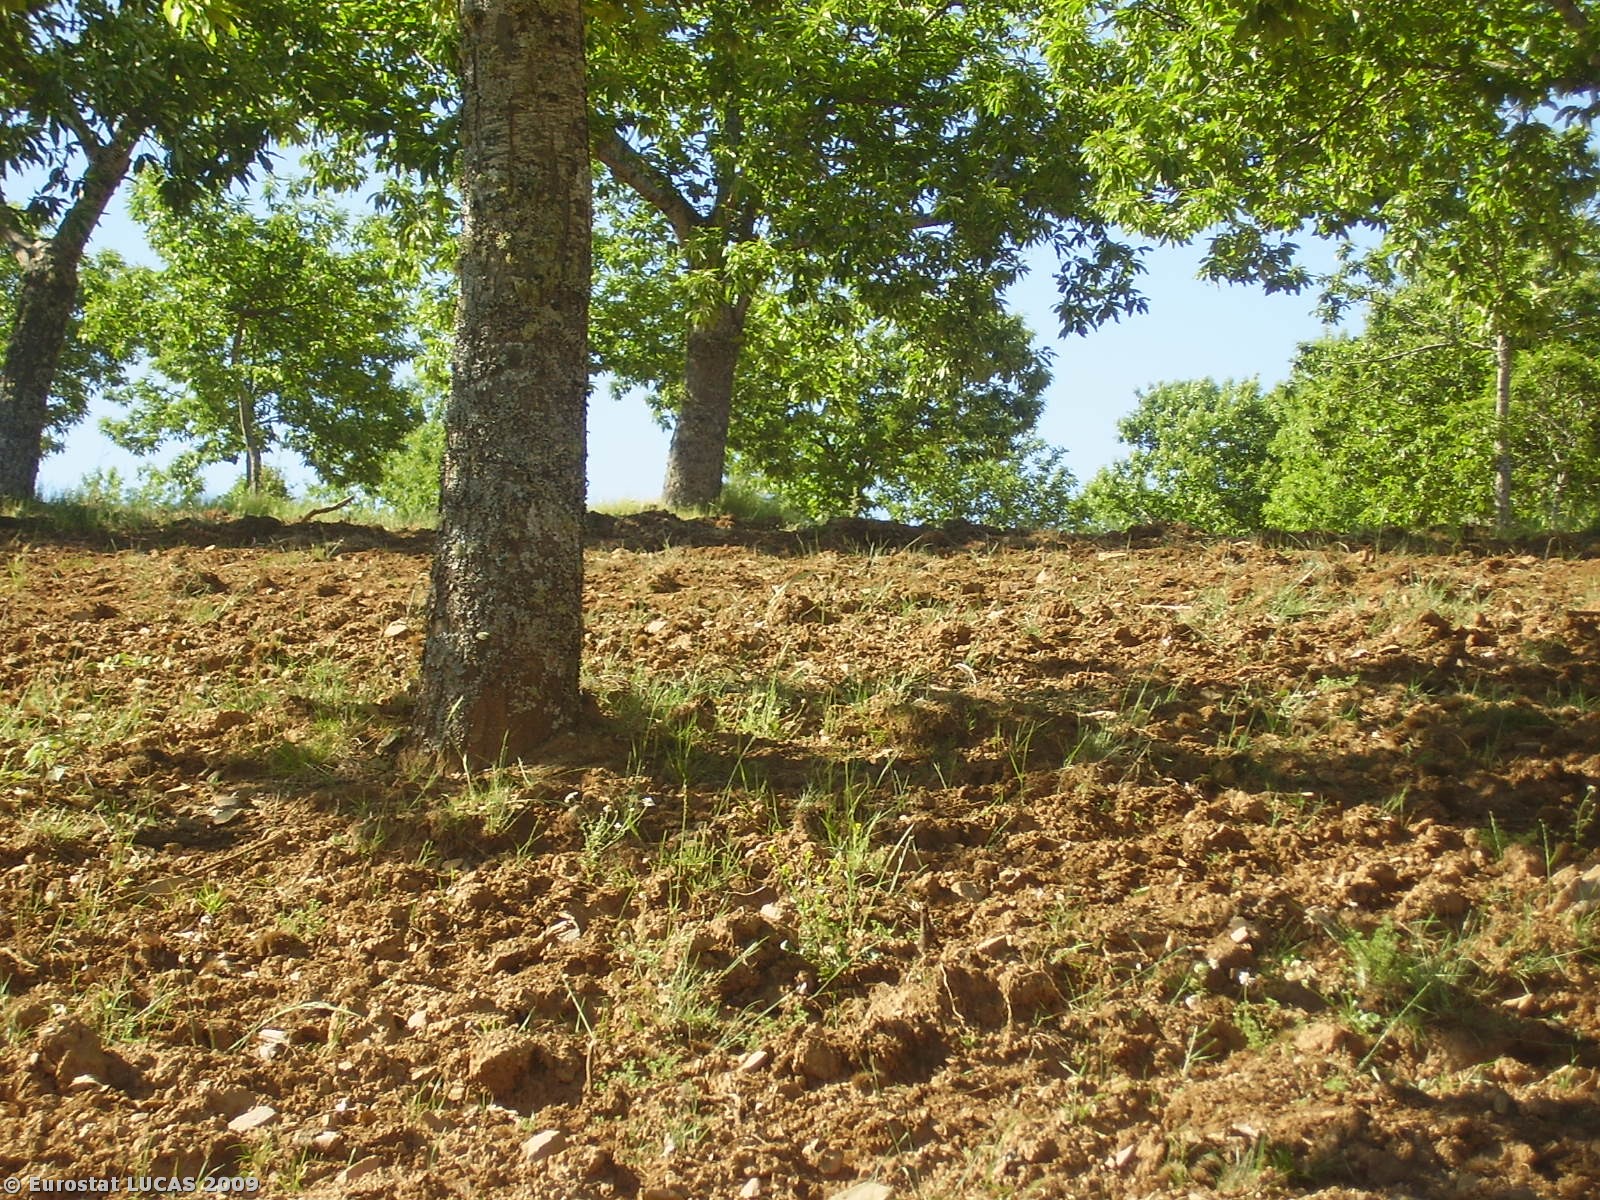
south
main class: Cropland
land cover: Other fruit trees and berries
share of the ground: 10 - 25 %
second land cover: Spontaneously vegetated surfaces
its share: < 10 %
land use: Agriculture (excluding fallow land and kitchen gardens)
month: June
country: PT
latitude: 41.7528
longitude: -6.9171
